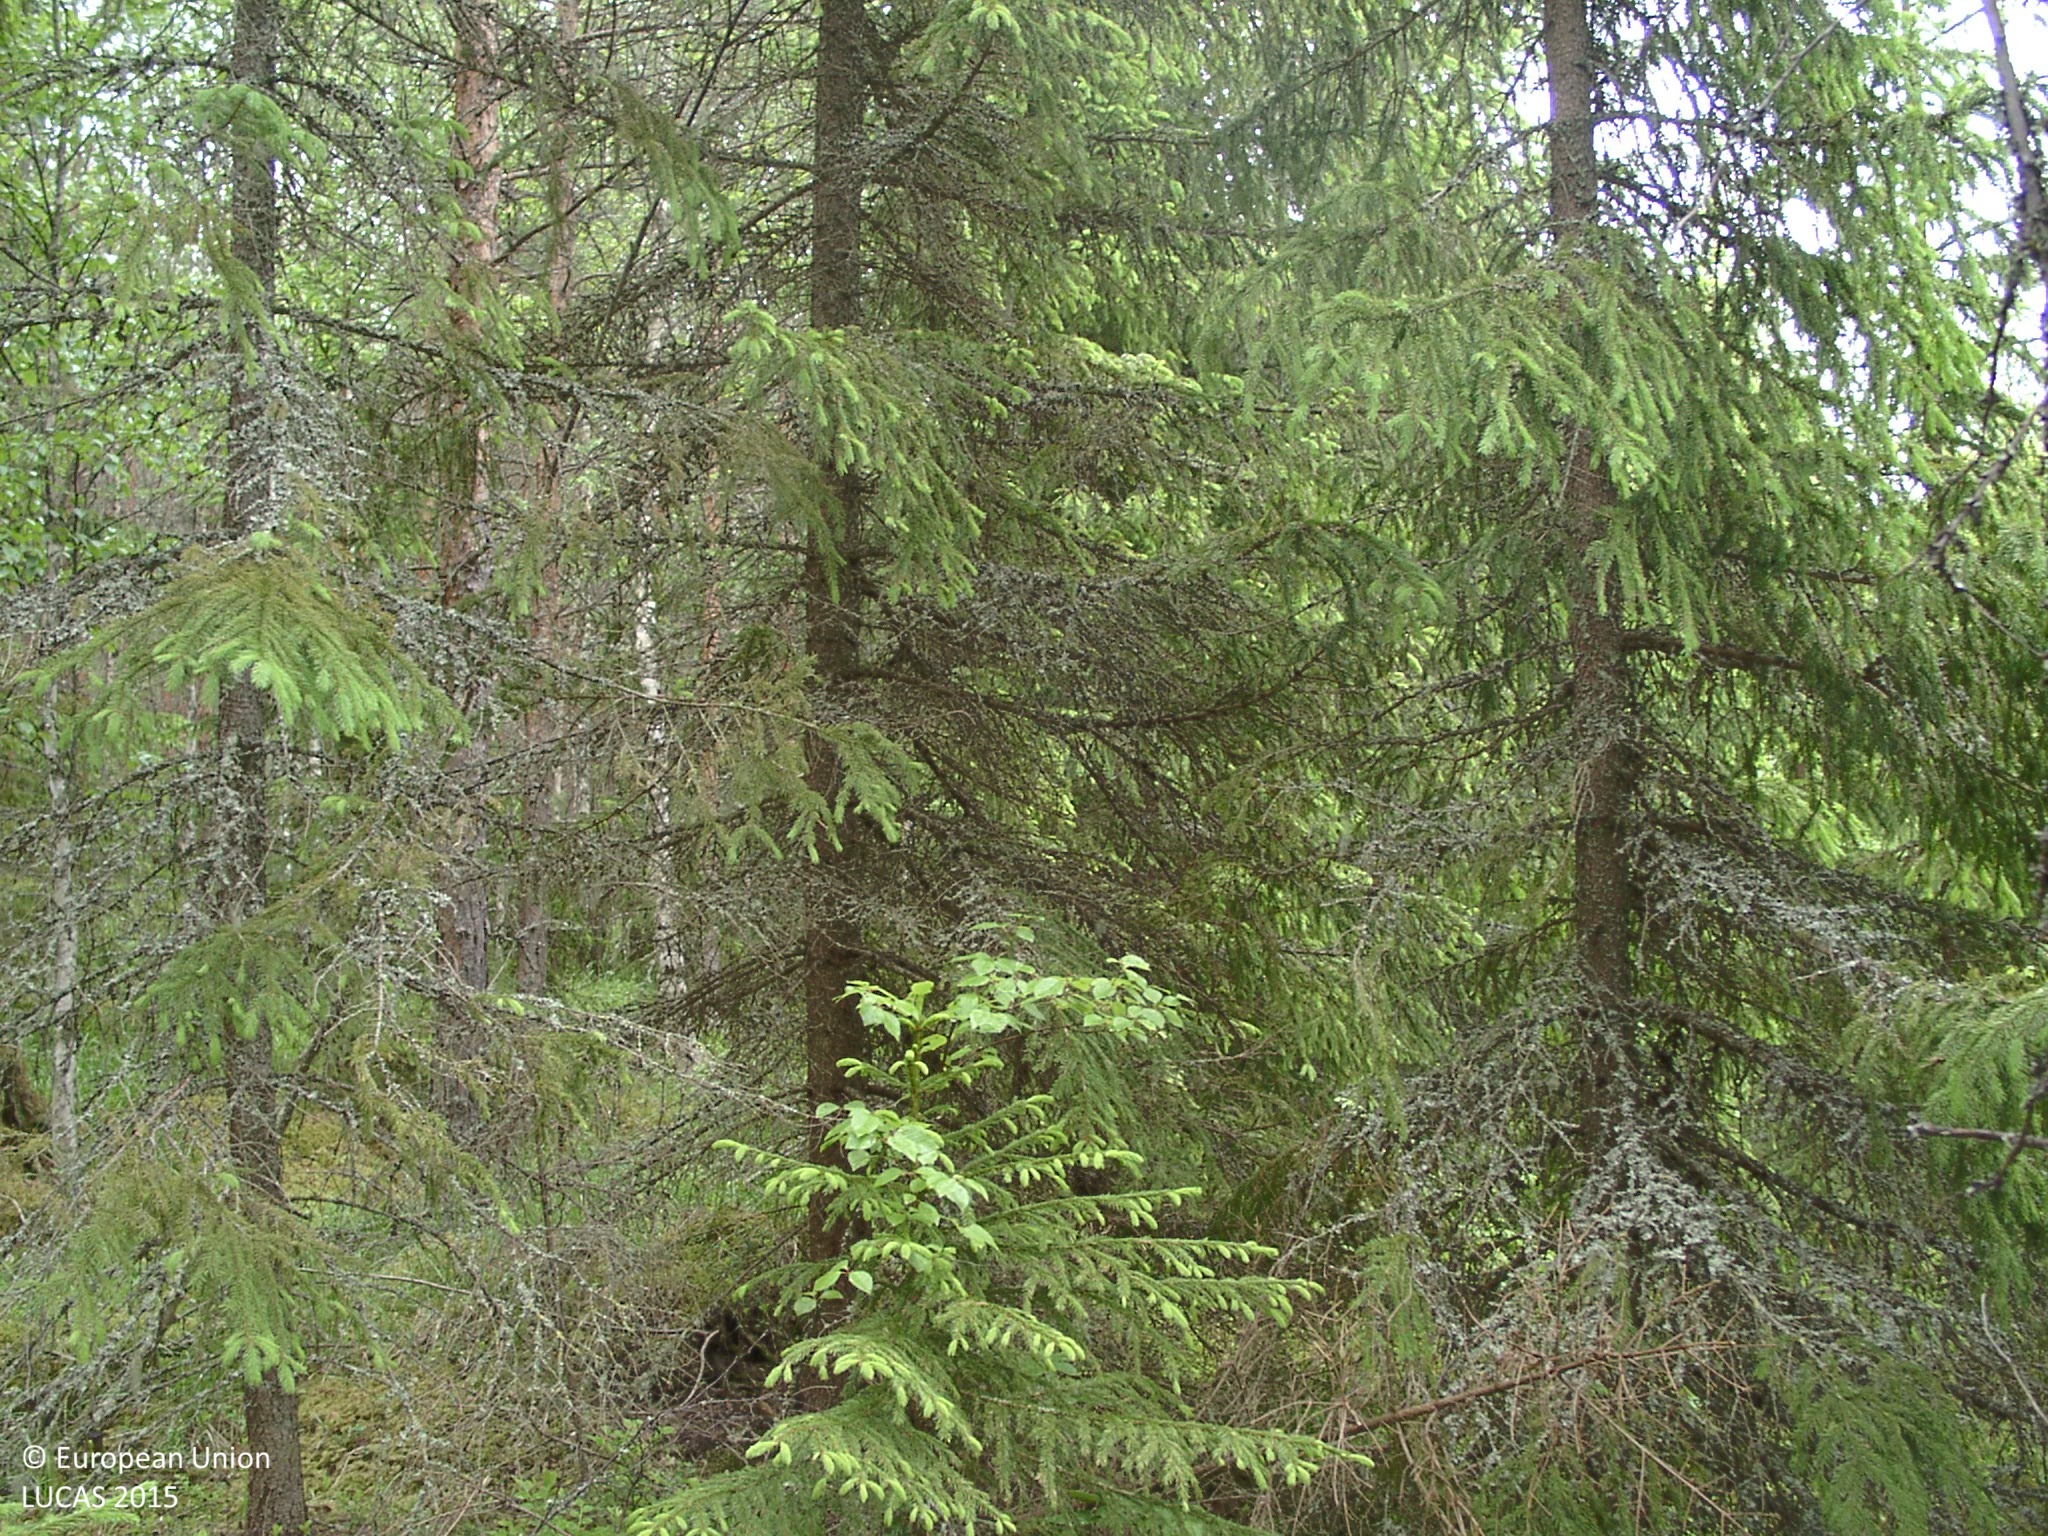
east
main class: Woodland
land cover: Spruce dominated mixed woodland
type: boreal forest
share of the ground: 50 - 75 %
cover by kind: coniferous forest trees 40 %, broadleaved forest trees 25 %, shrubs 20 %, herbaceous plants 10 %, lichens and mosses 5 %
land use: Semi-natural and natural areas not in use
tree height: > 5 m
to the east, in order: Spruce dominated mixed woodland; Pine dominated mixed woodland; Other mixed woodland; Spruce dominated mixed woodland
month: June
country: FI
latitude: 61.6819
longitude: 24.7089
